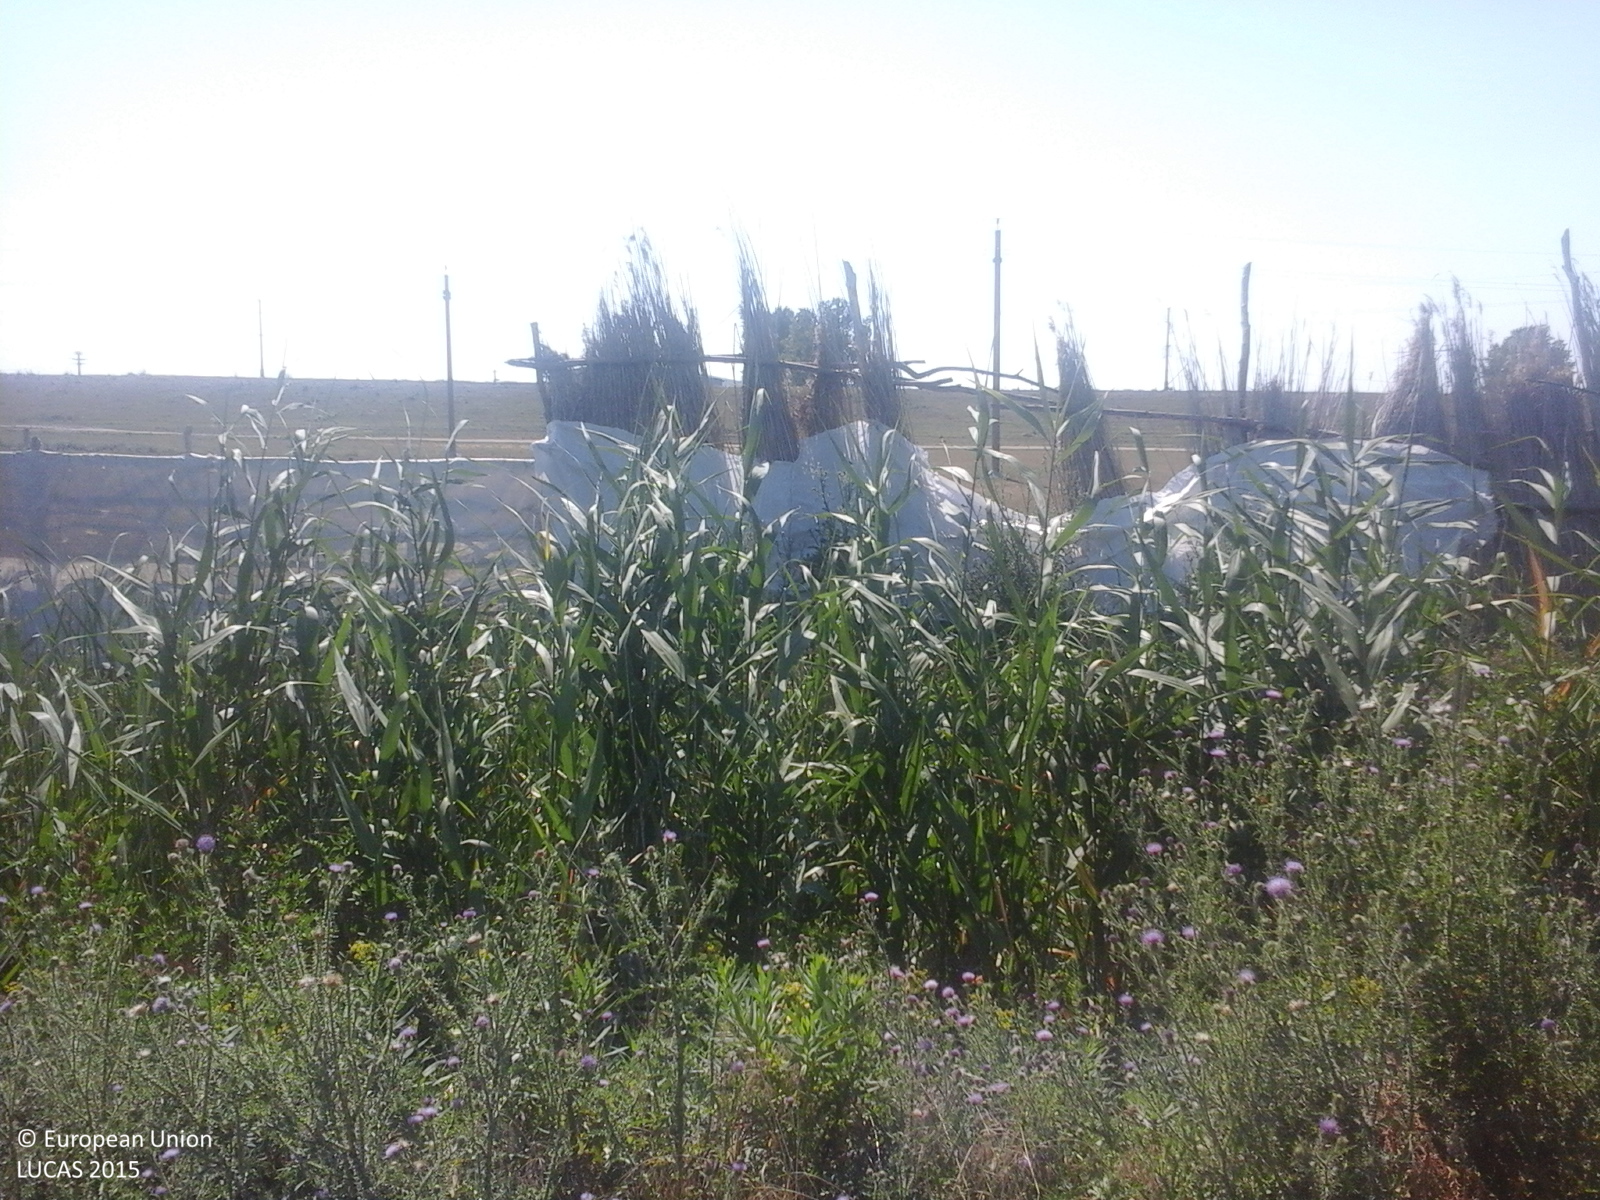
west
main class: Cropland
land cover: Soya
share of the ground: < 10 %
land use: Agriculture (excluding fallow land and kitchen gardens)
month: July
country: RO
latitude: 44.1833
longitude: 27.1292
